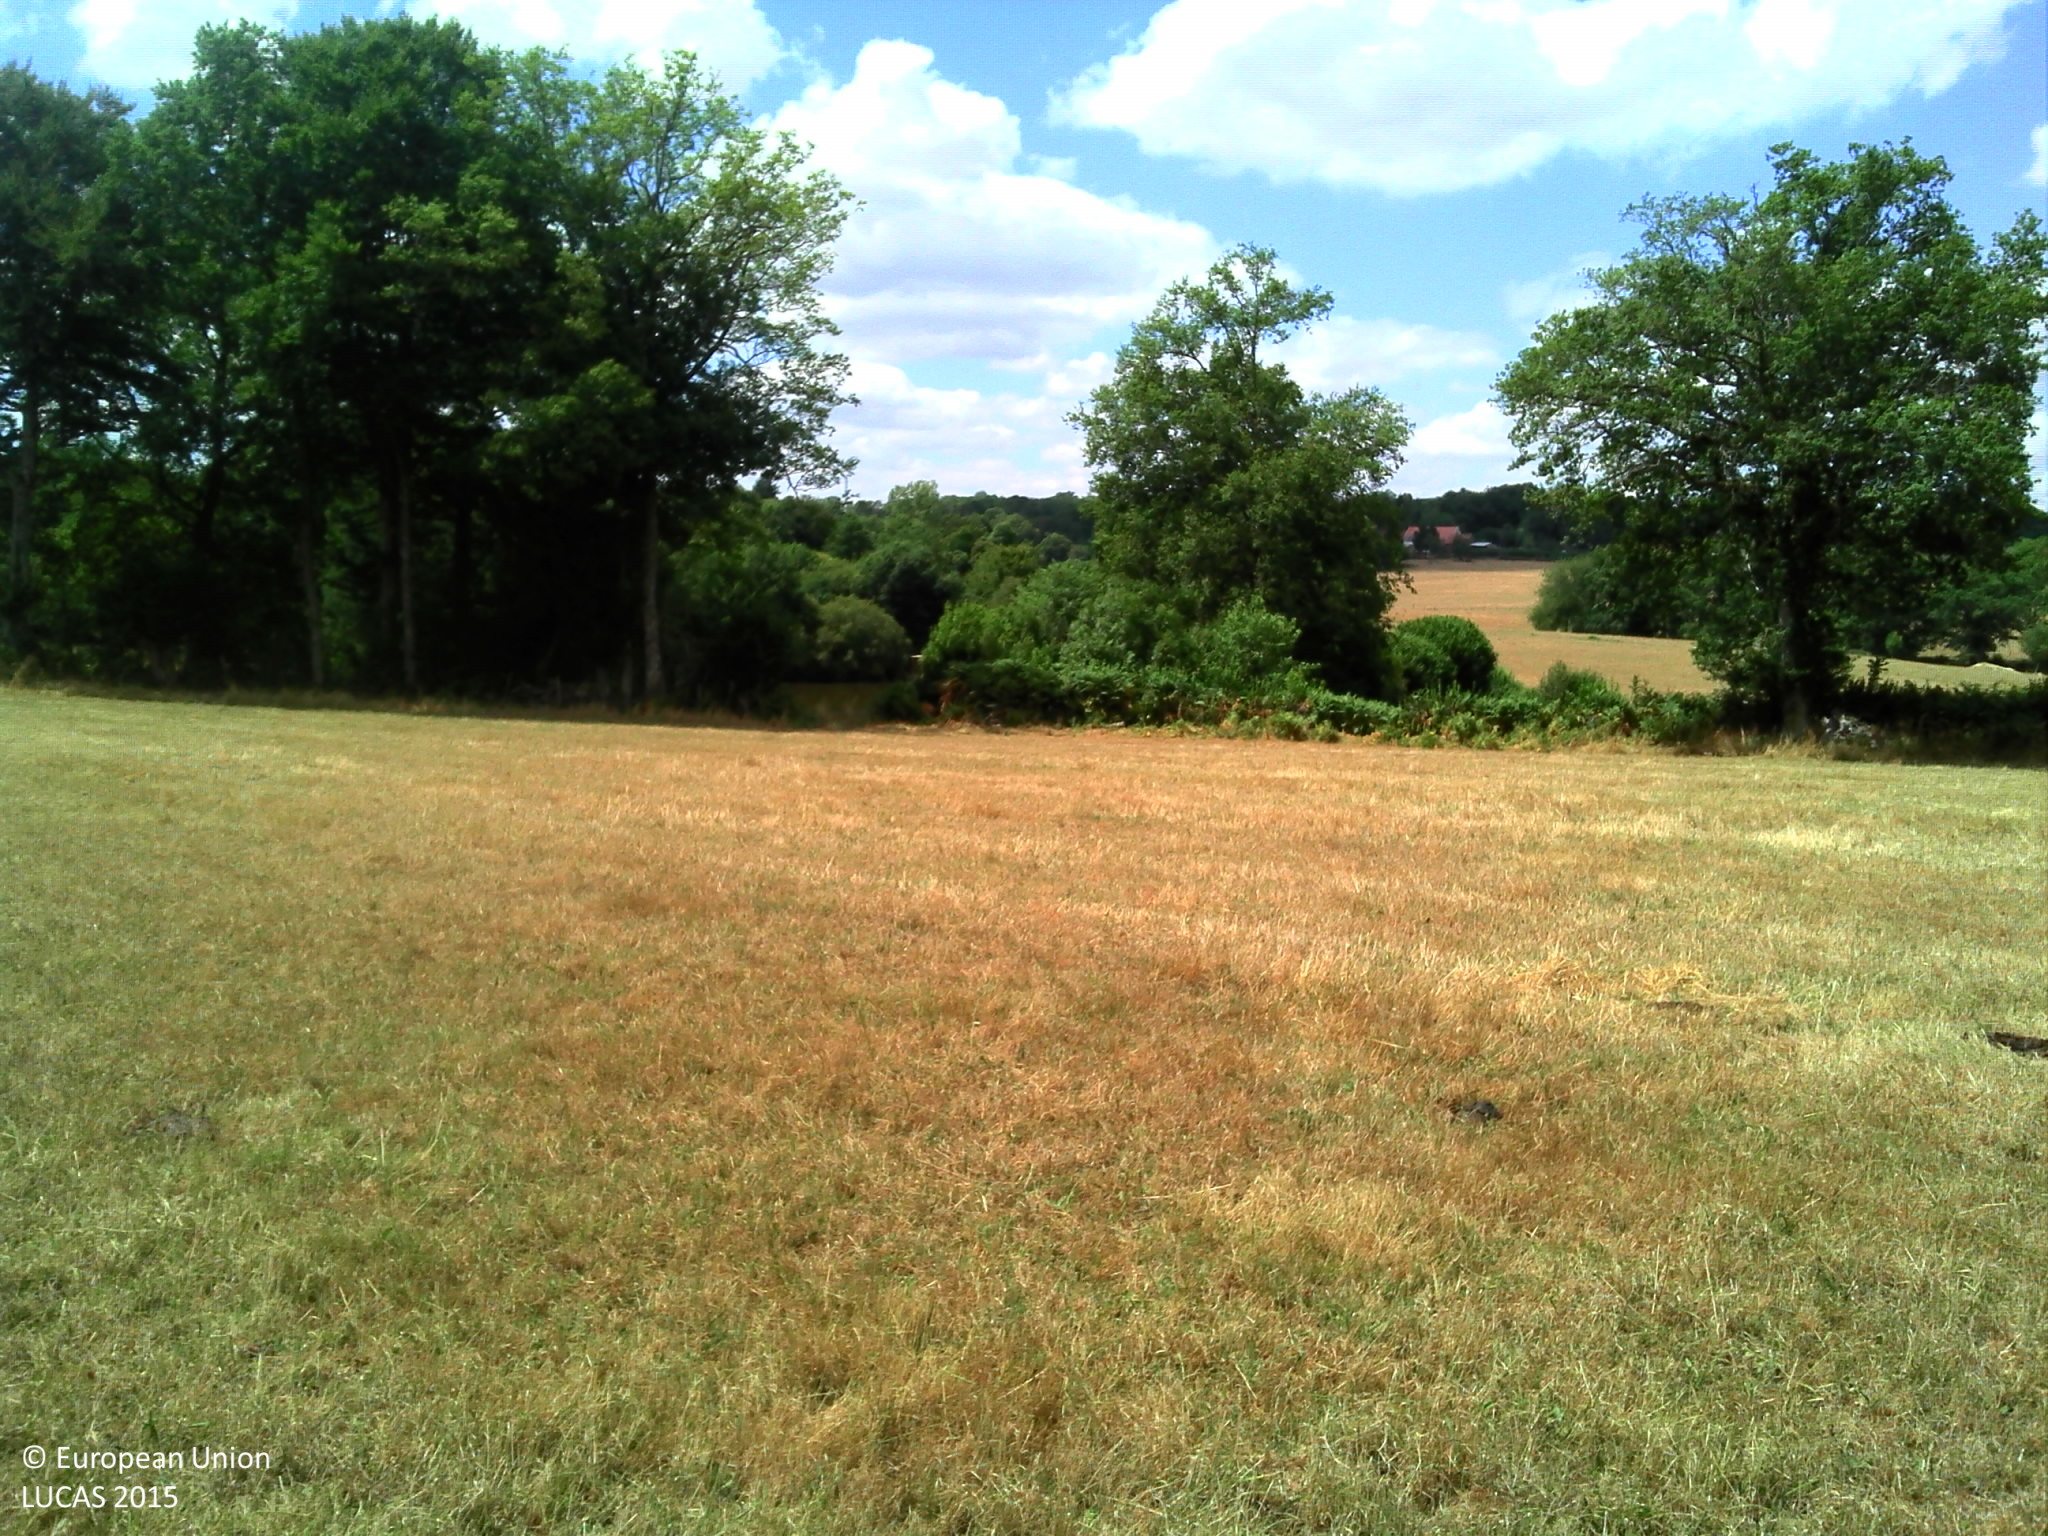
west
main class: Grassland
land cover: Grassland without tree/shrub cover
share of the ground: > 75 %
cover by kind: herbaceous plants 100 %
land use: Agriculture (excluding fallow land and kitchen gardens)
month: July
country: FR
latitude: 46.4297
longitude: 2.2249
